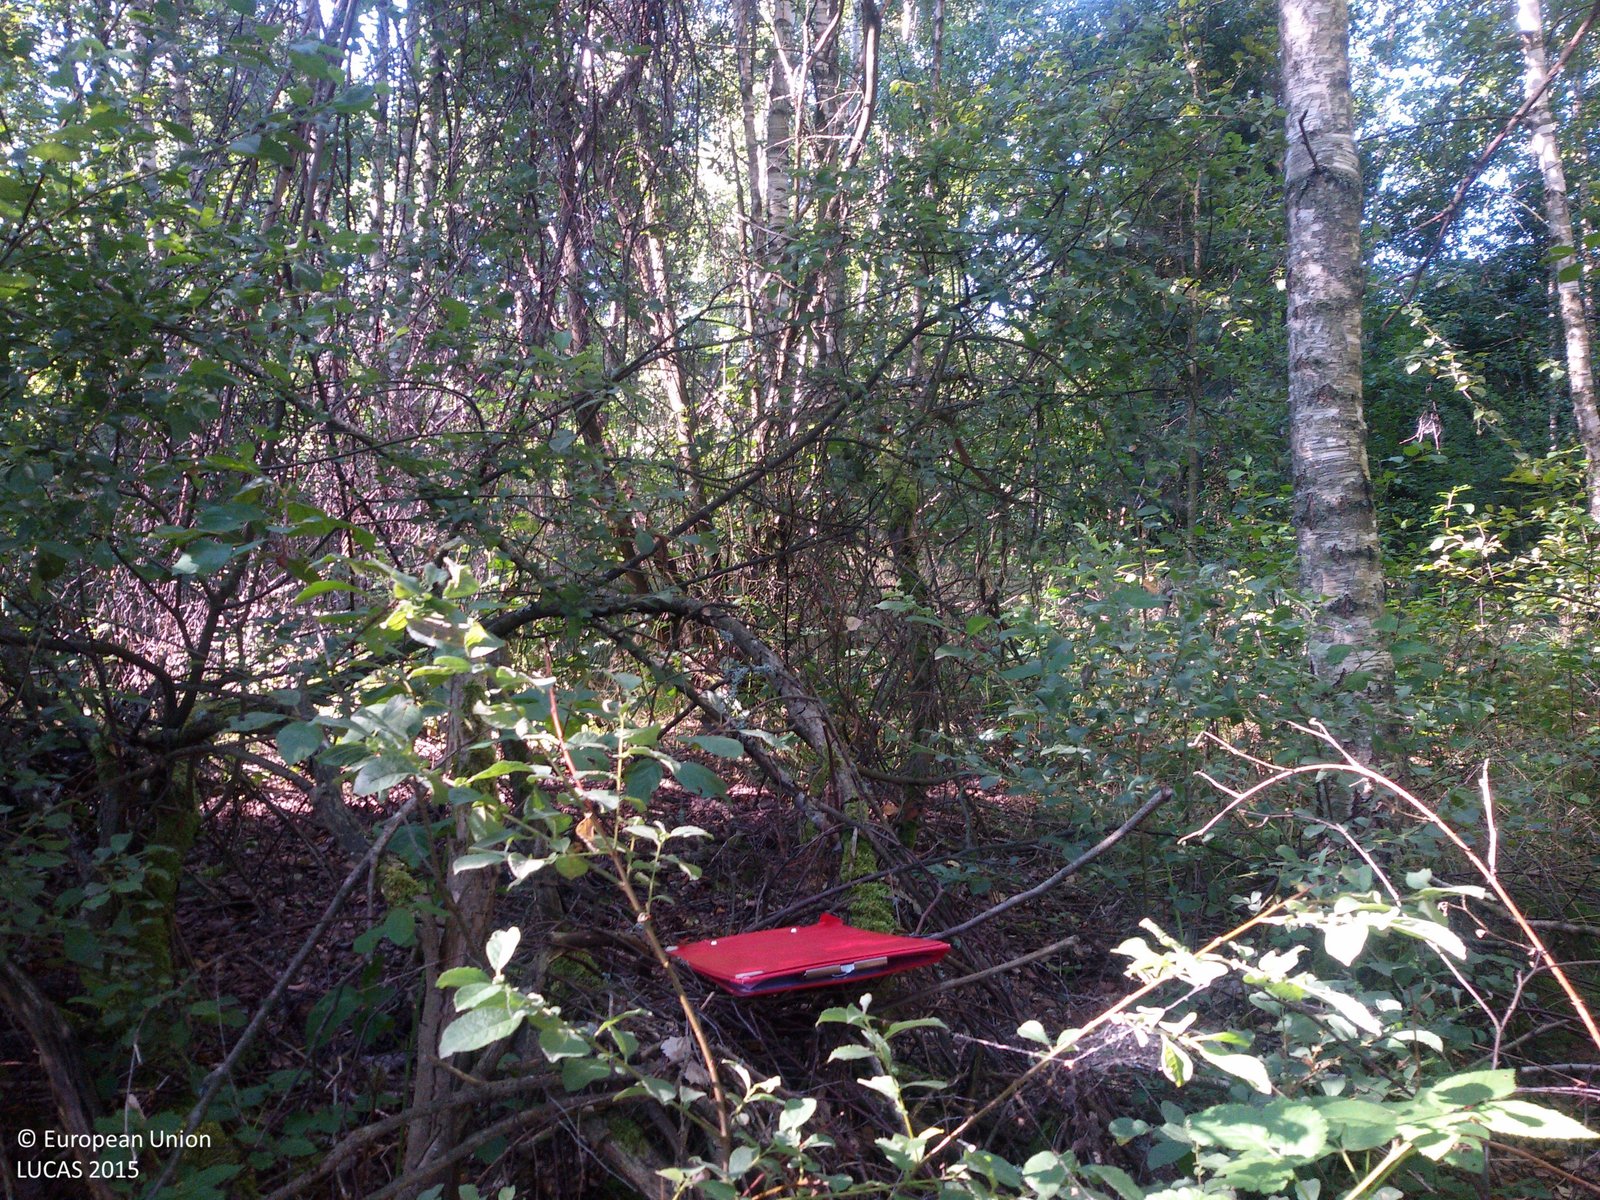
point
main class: Woodland
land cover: Broadleaved woodland
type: mesophytic deciduous forest
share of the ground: > 75 %
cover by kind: broadleaved forest trees 60 %, shrubs 40 %
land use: Semi-natural and natural areas not in use
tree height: > 5 m
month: August
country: PL
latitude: 54.0894
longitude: 17.2103
